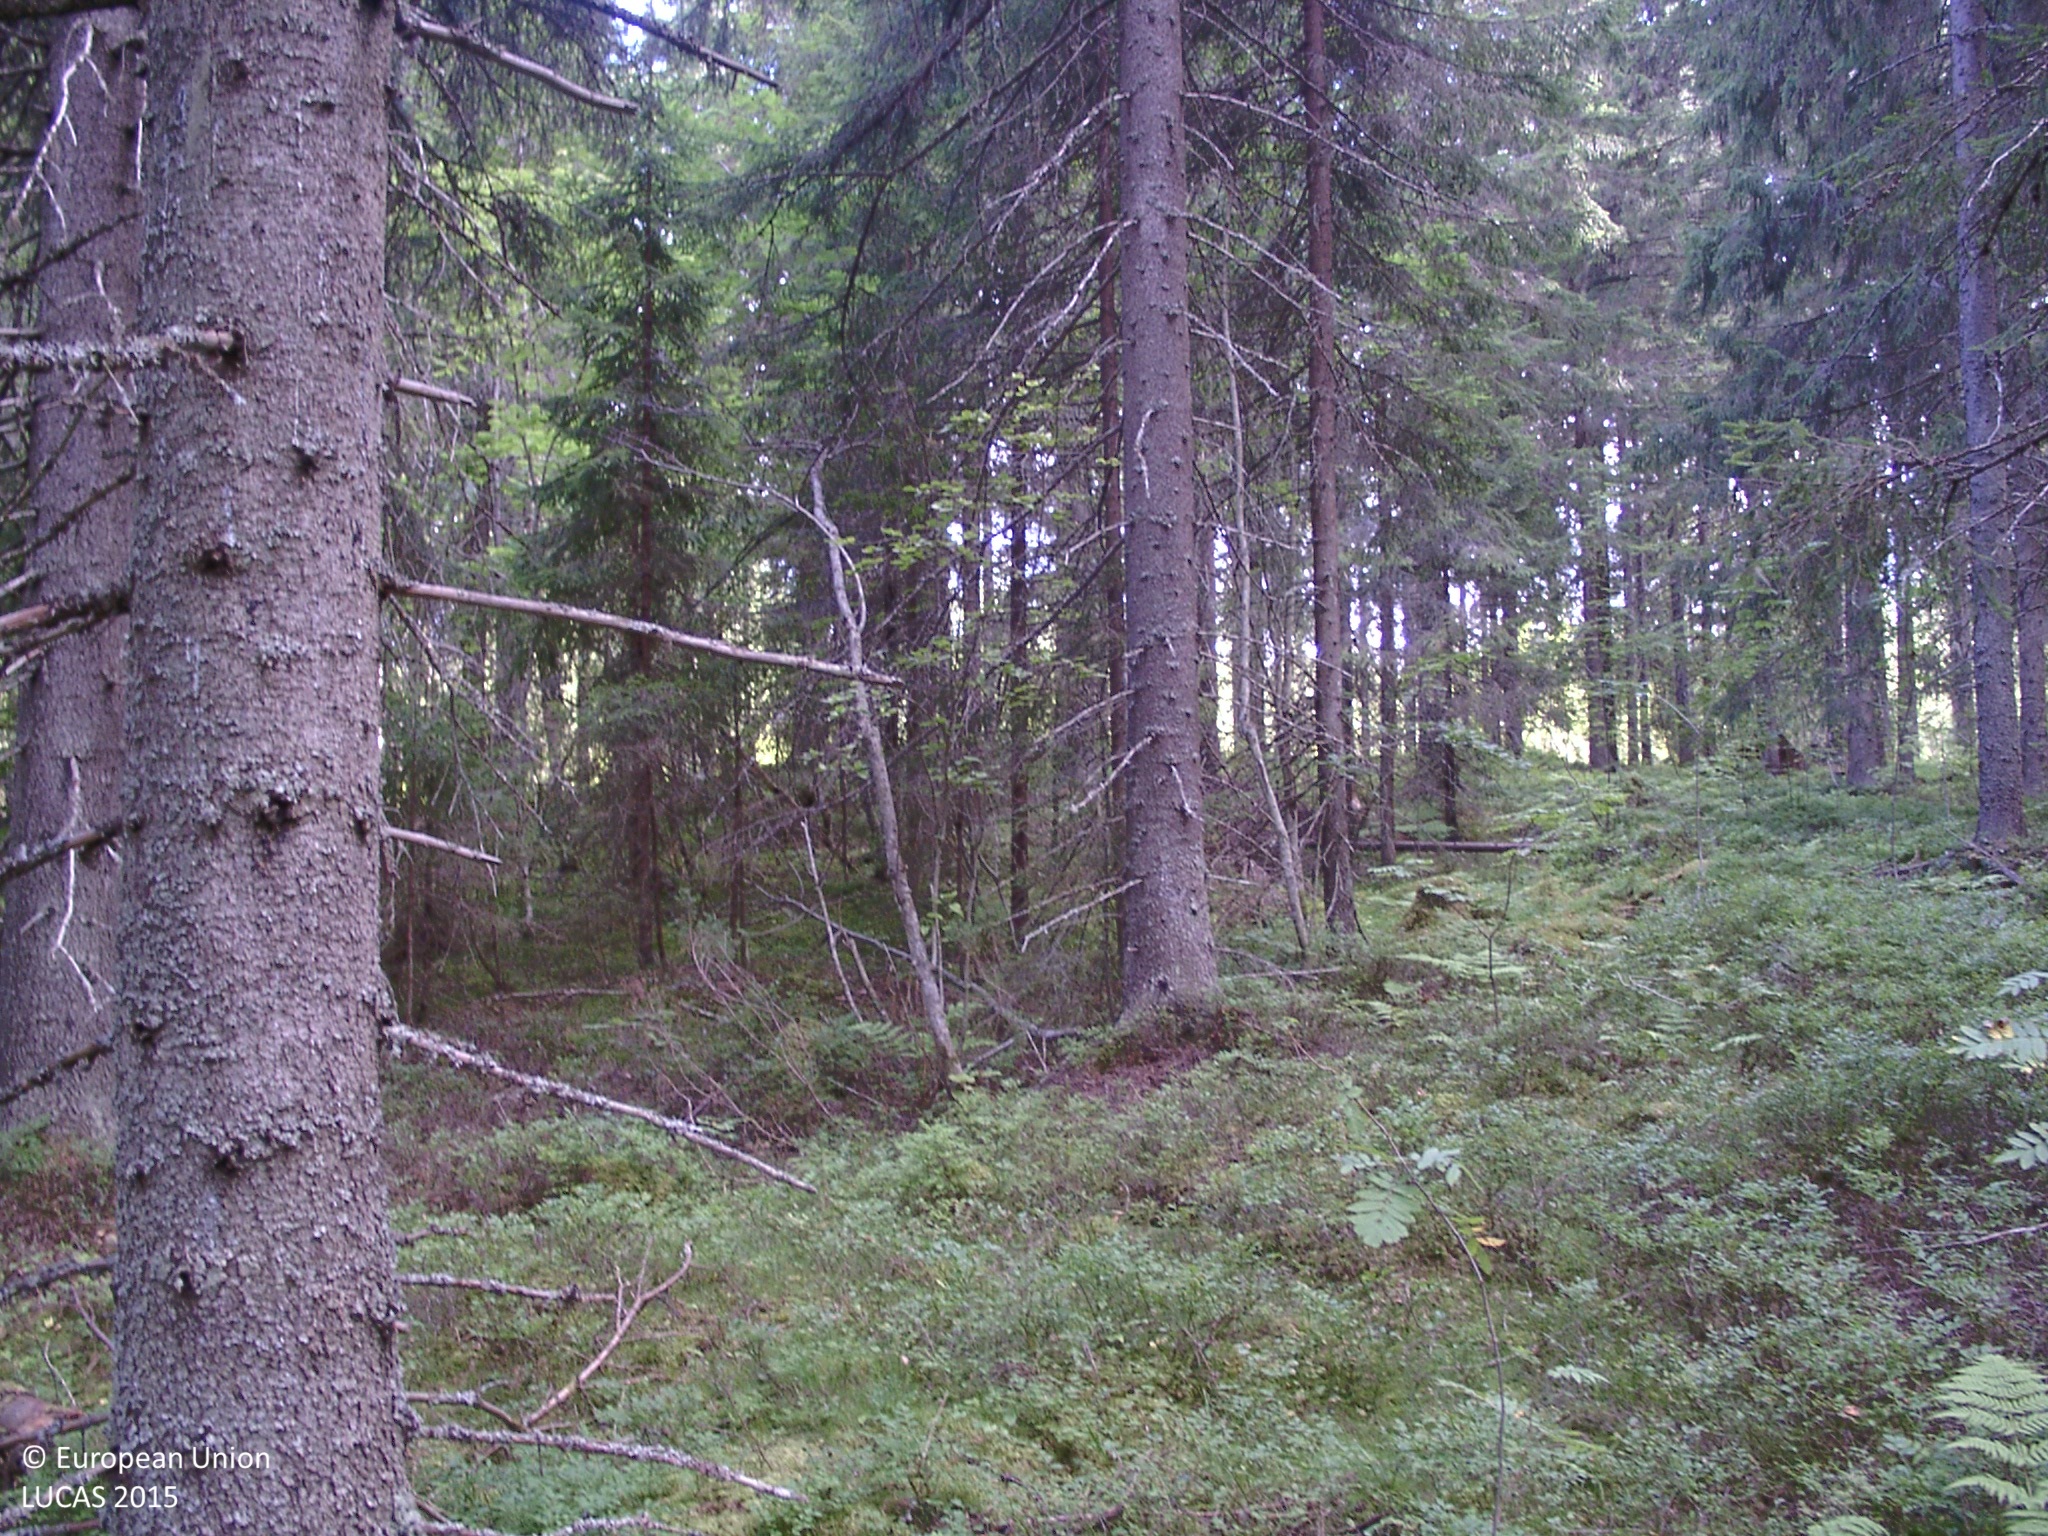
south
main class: Woodland
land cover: Spruce dominated coniferous woodland
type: boreal forest
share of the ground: > 75 %
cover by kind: coniferous forest trees 75 %, shrubs 10 %, broadleaved forest trees 5 %, herbaceous plants 5 %, lichens and mosses 5 %
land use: Forestry
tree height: > 5 m
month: August
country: FI
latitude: 62.4071
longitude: 25.5374
